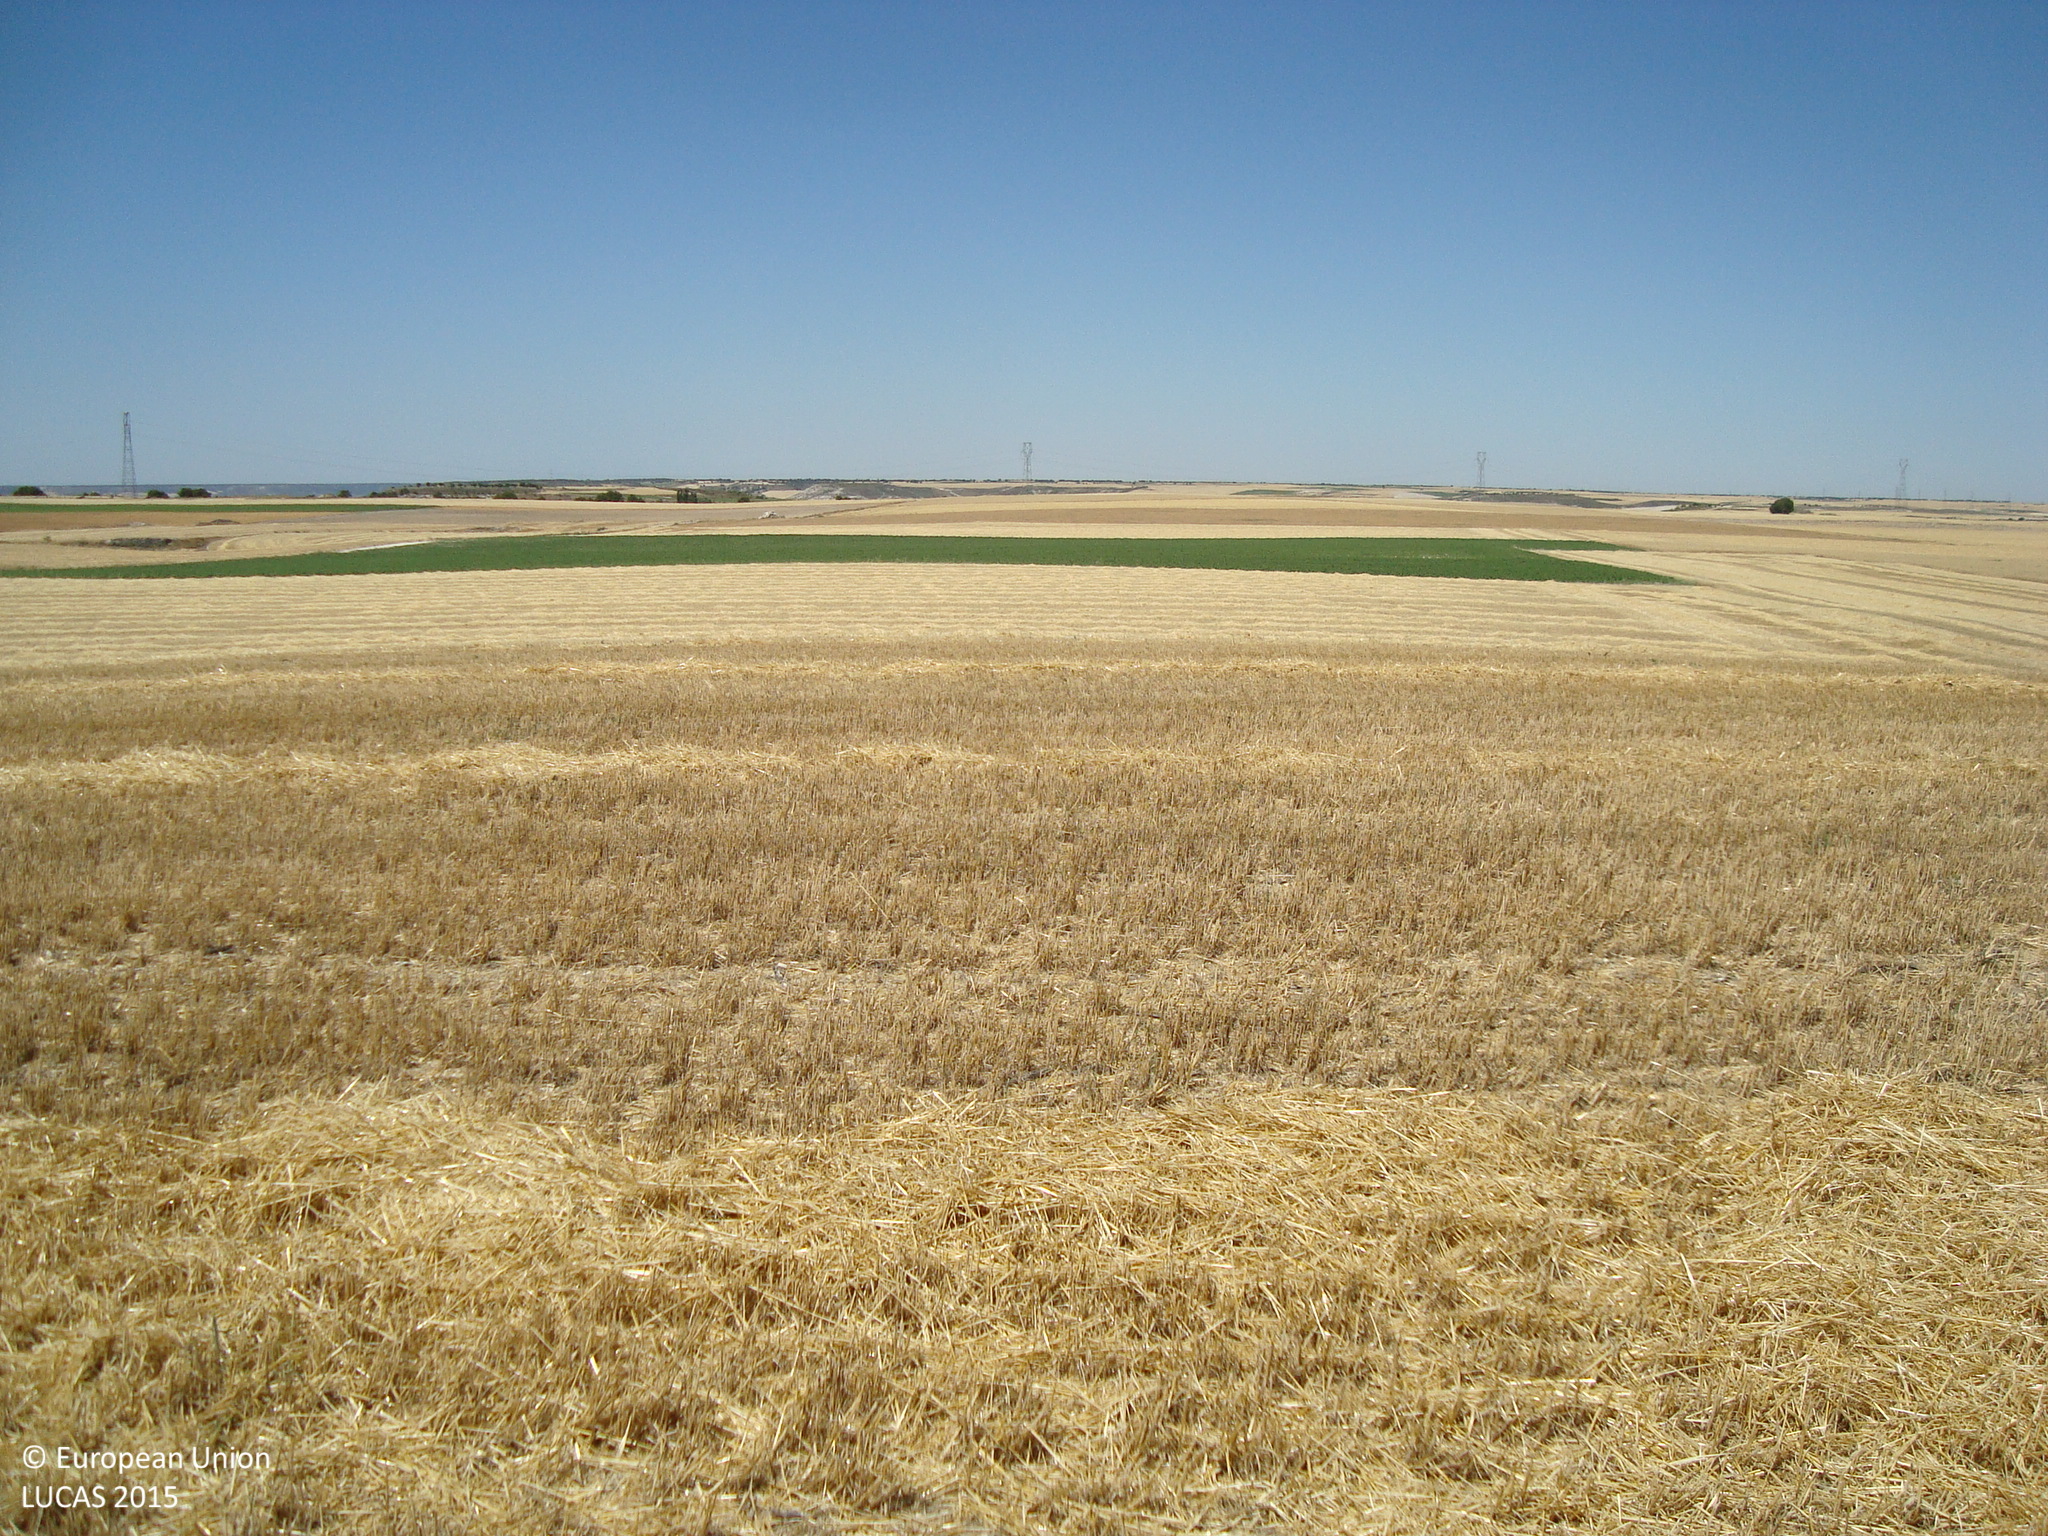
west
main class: Cropland
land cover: Barley
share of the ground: < 10 %
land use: Agriculture (excluding fallow land and kitchen gardens)
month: July
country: ES
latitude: 41.6801
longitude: -4.1021
